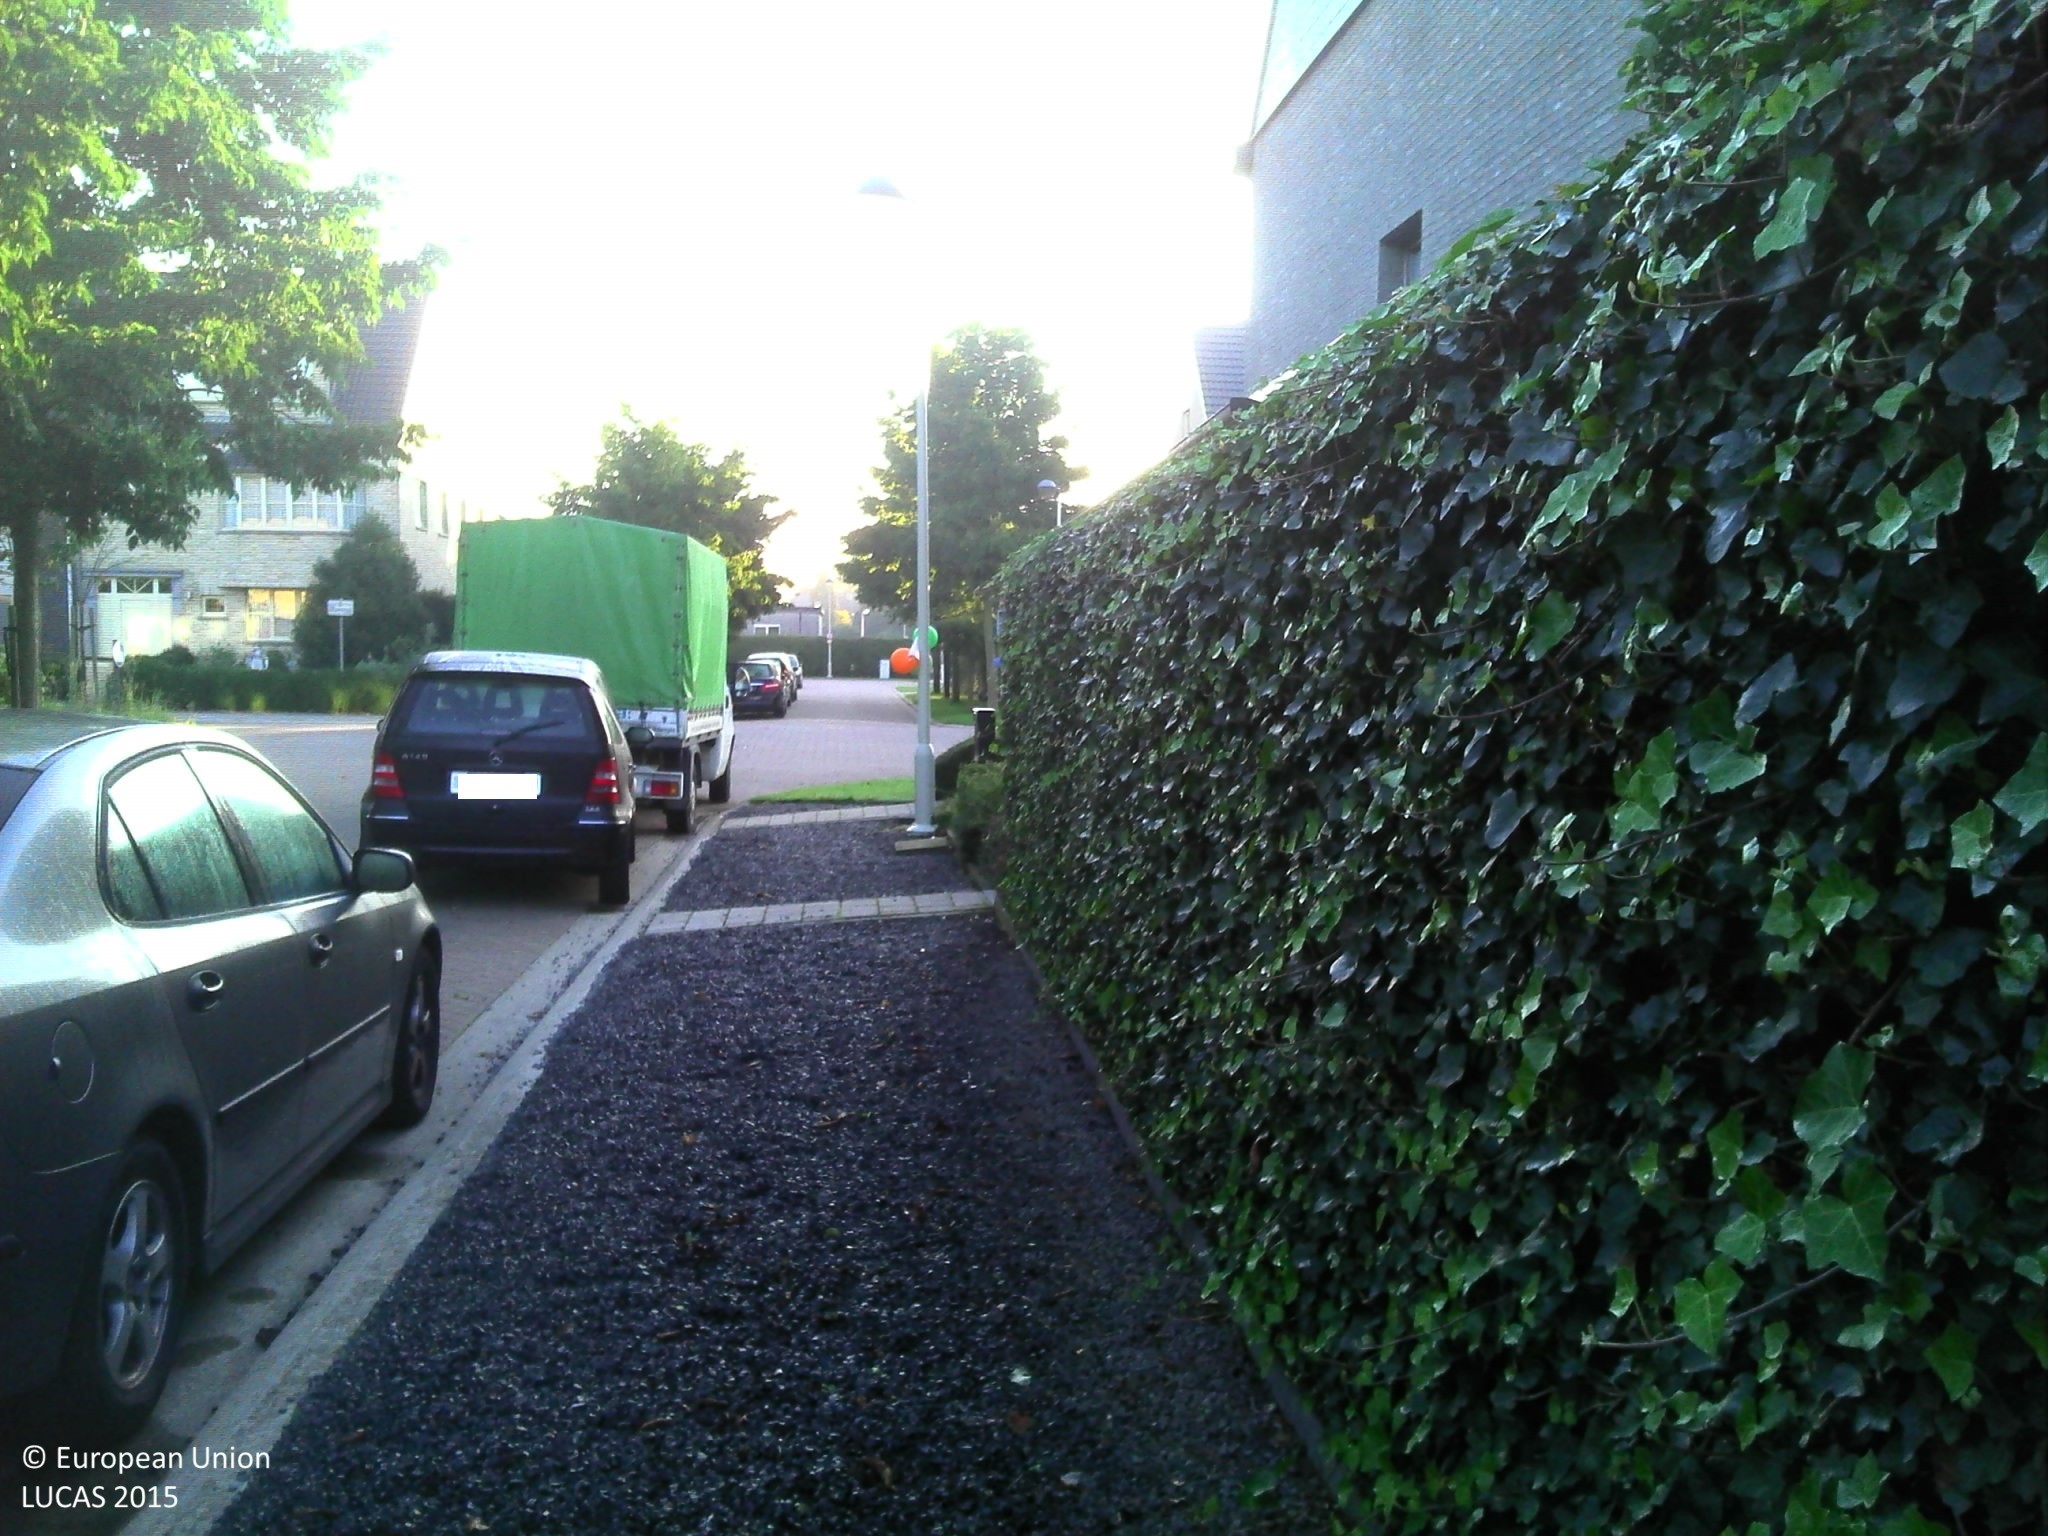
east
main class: Grassland
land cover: Grassland without tree/shrub cover
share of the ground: > 75 %
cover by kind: herbaceous plants 100 %
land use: Residential
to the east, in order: Grassland without tree/shrub cover; Artificial constructions in urban areas
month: September
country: BE
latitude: 51.2235
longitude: 4.5117
